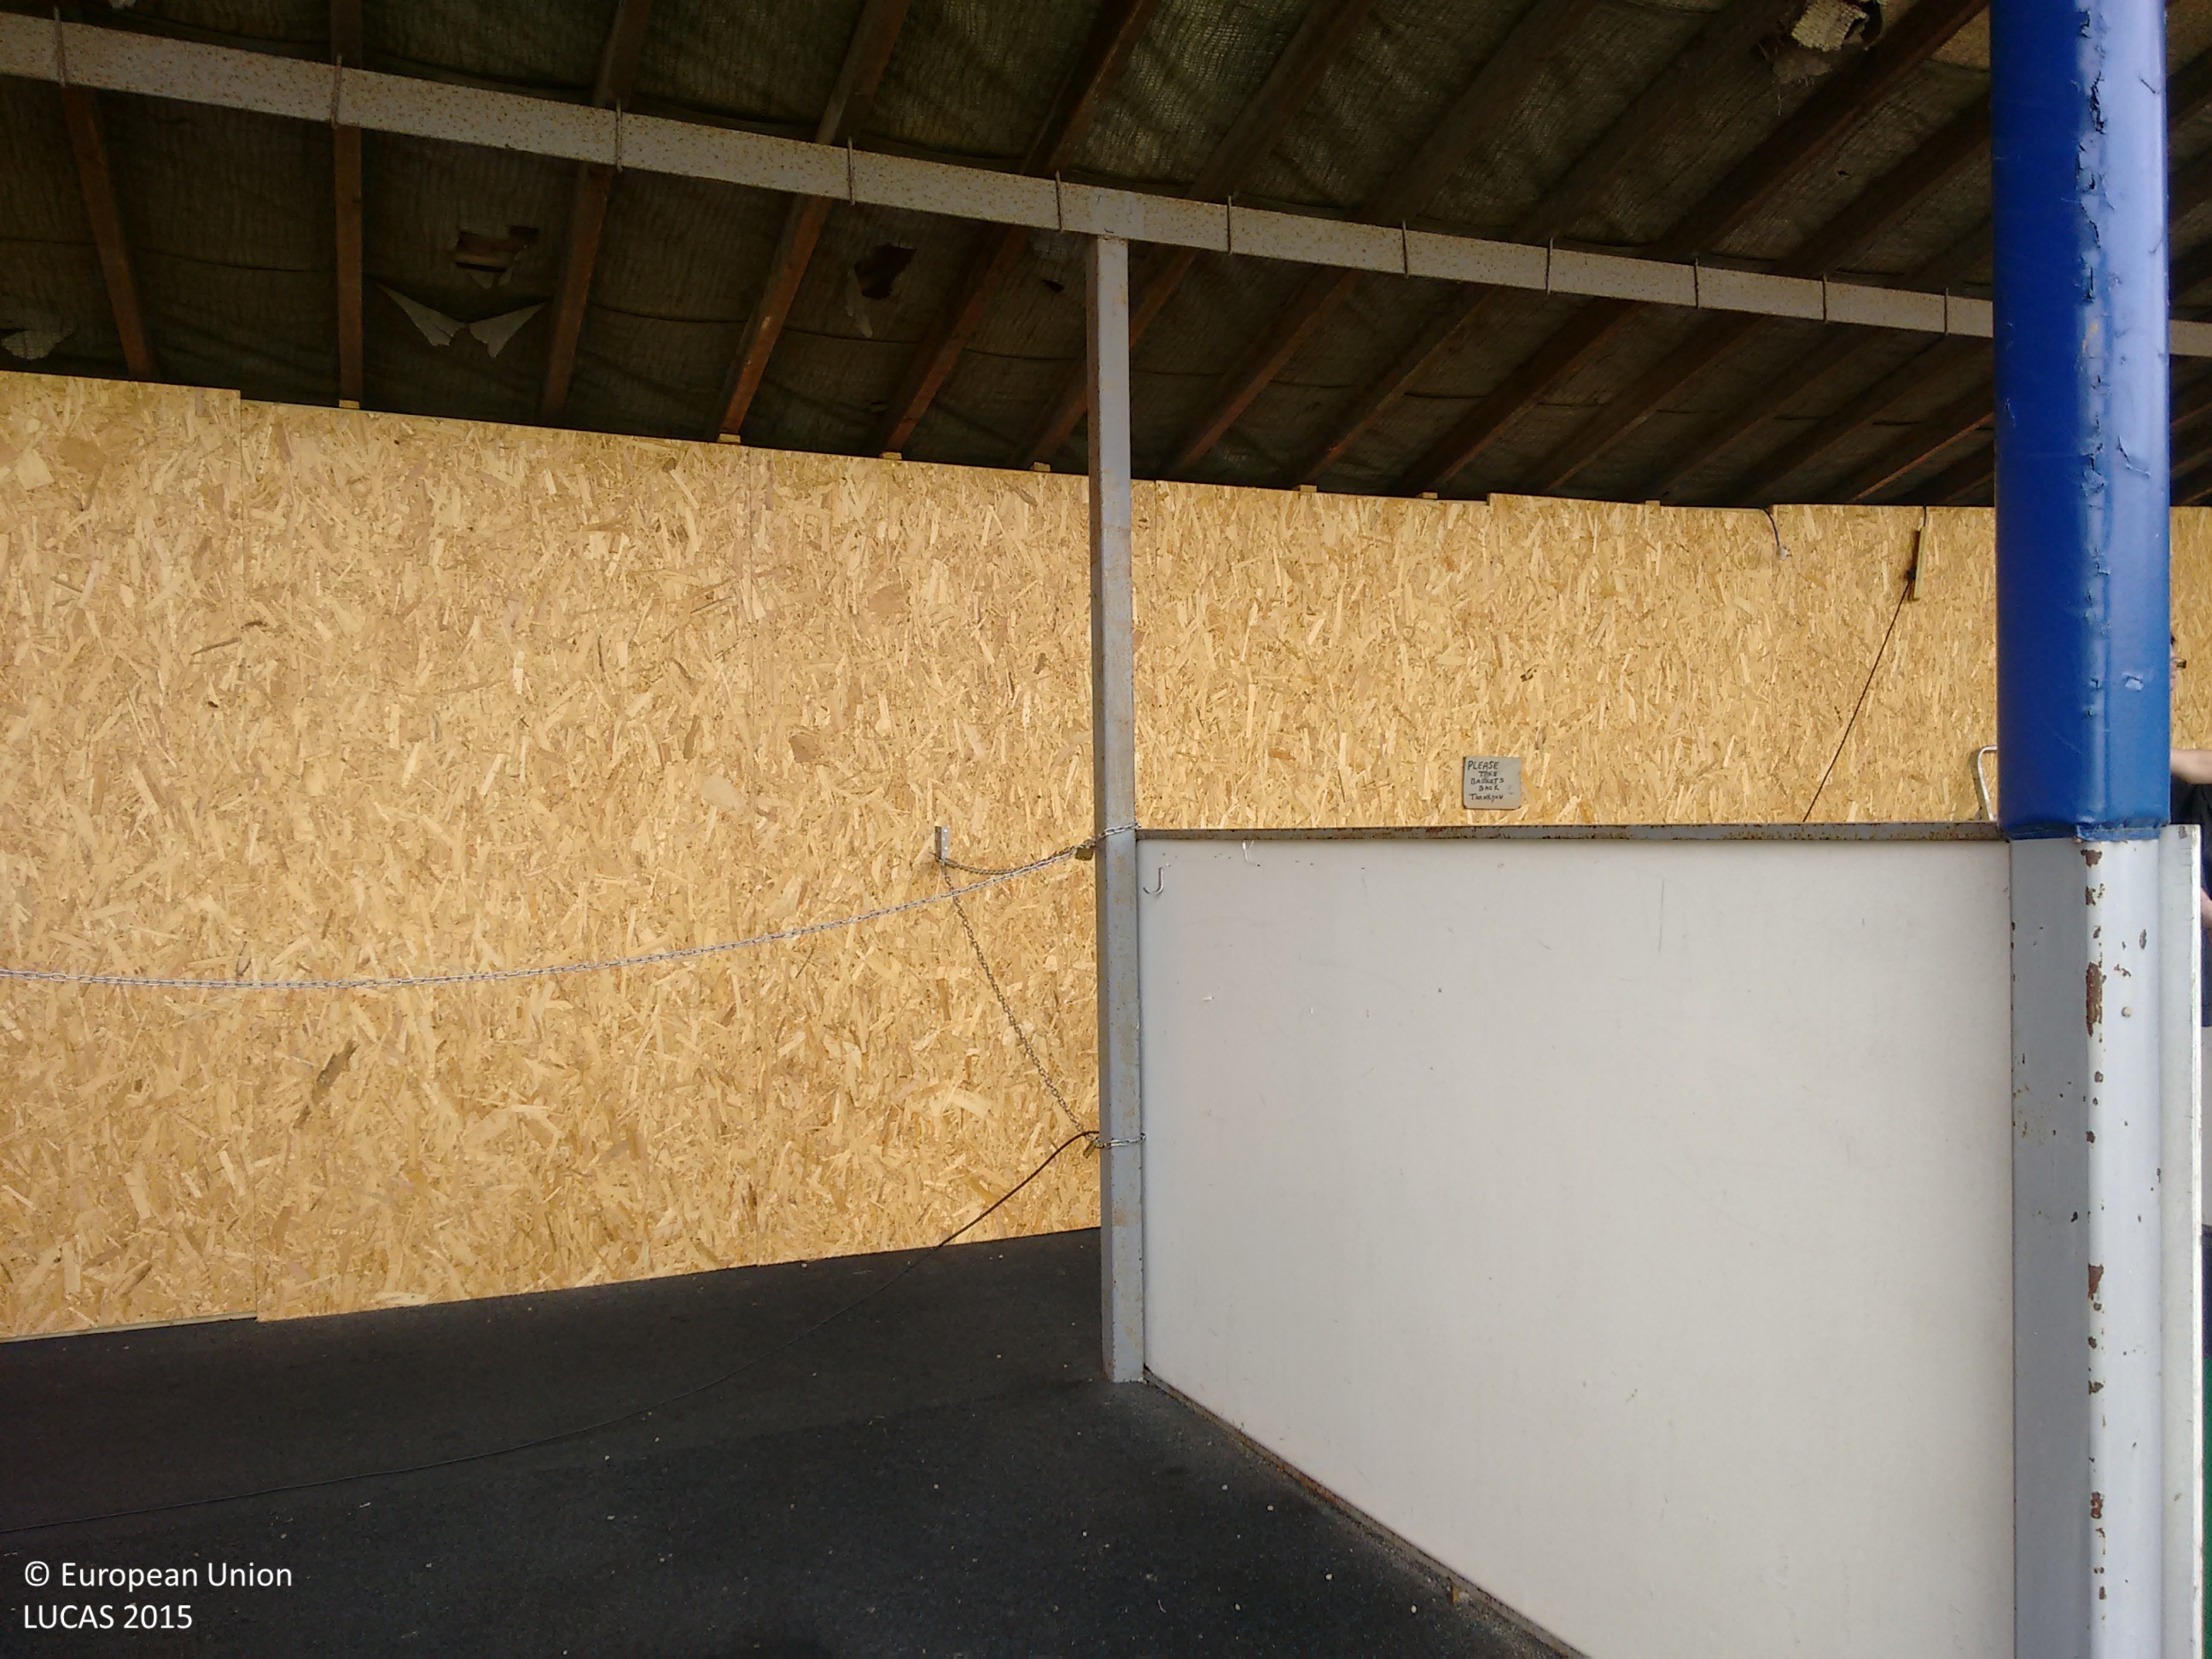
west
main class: Grassland
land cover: Grassland without tree/shrub cover
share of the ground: > 75 %
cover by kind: unconsolidated bare surface 60 %, herbaceous plants 40 %
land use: Sport
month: April
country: GB
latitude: 51.3650
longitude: 0.5360
